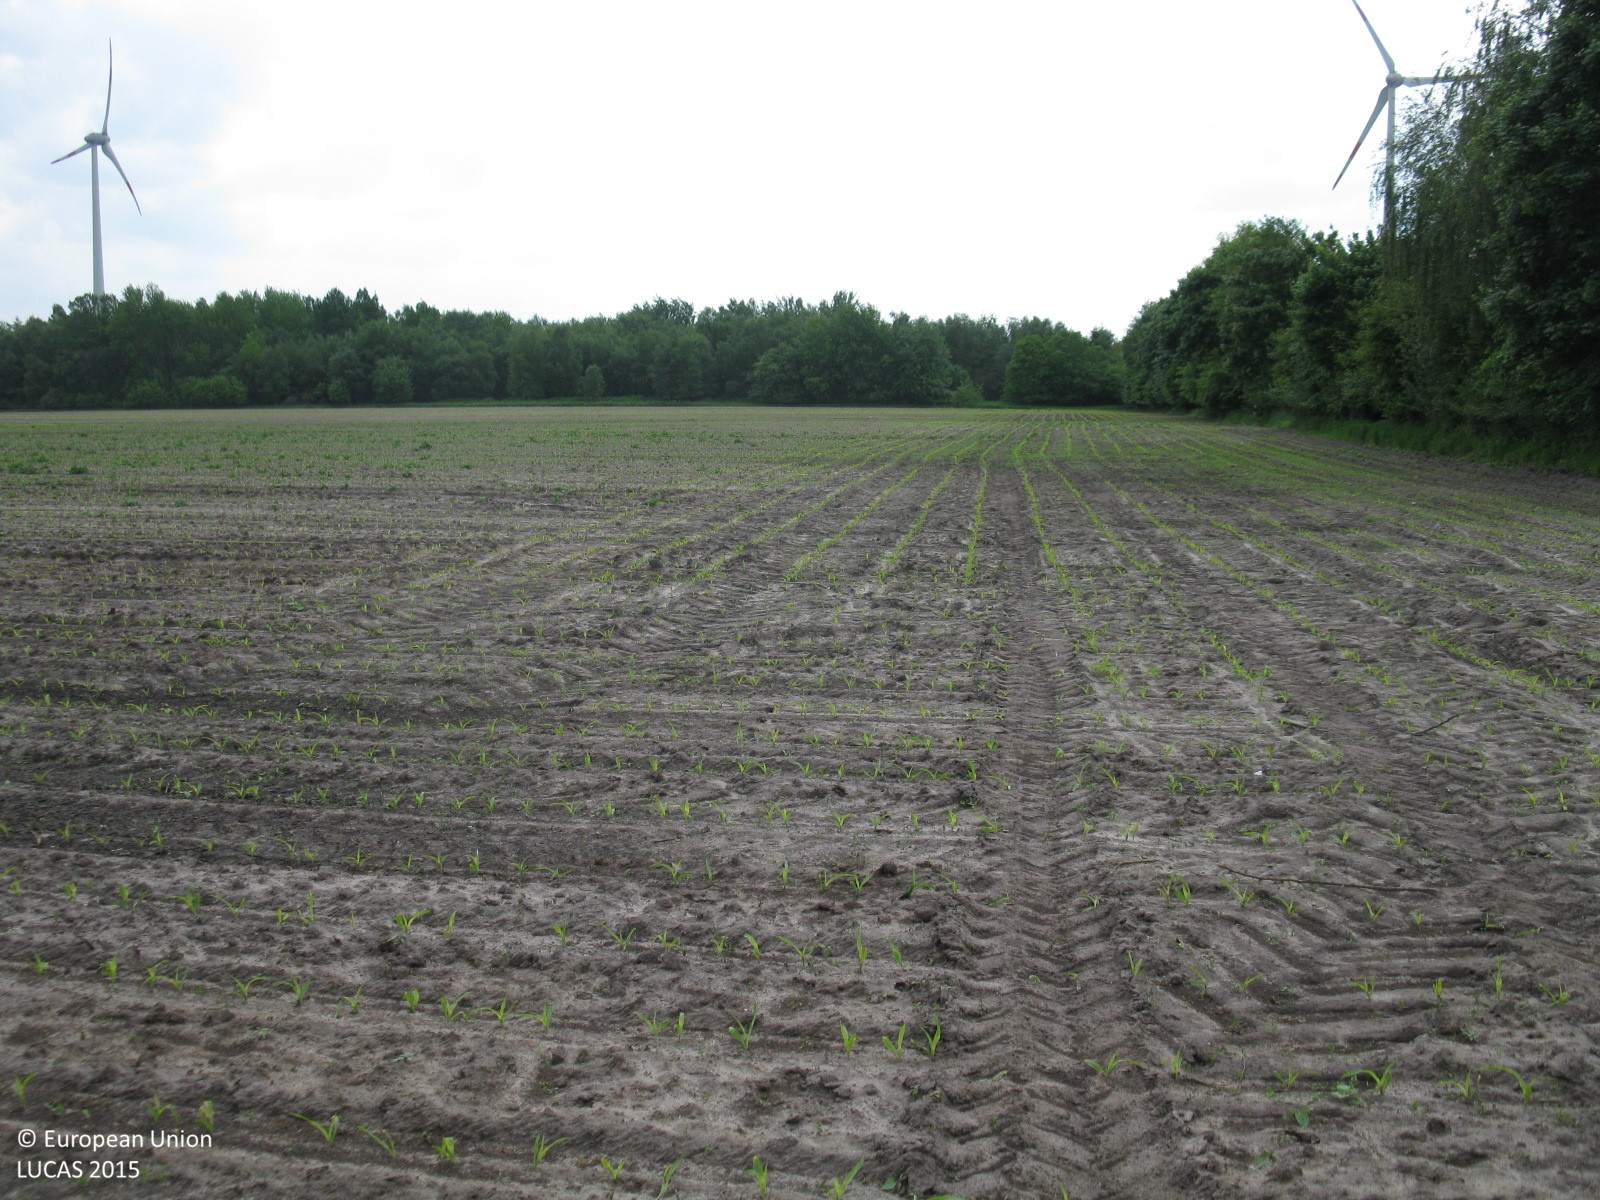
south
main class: Cropland
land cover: Maize
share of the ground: < 10 %
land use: Agriculture (excluding fallow land and kitchen gardens)
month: May
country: DE
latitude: 52.9789
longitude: 7.4240
